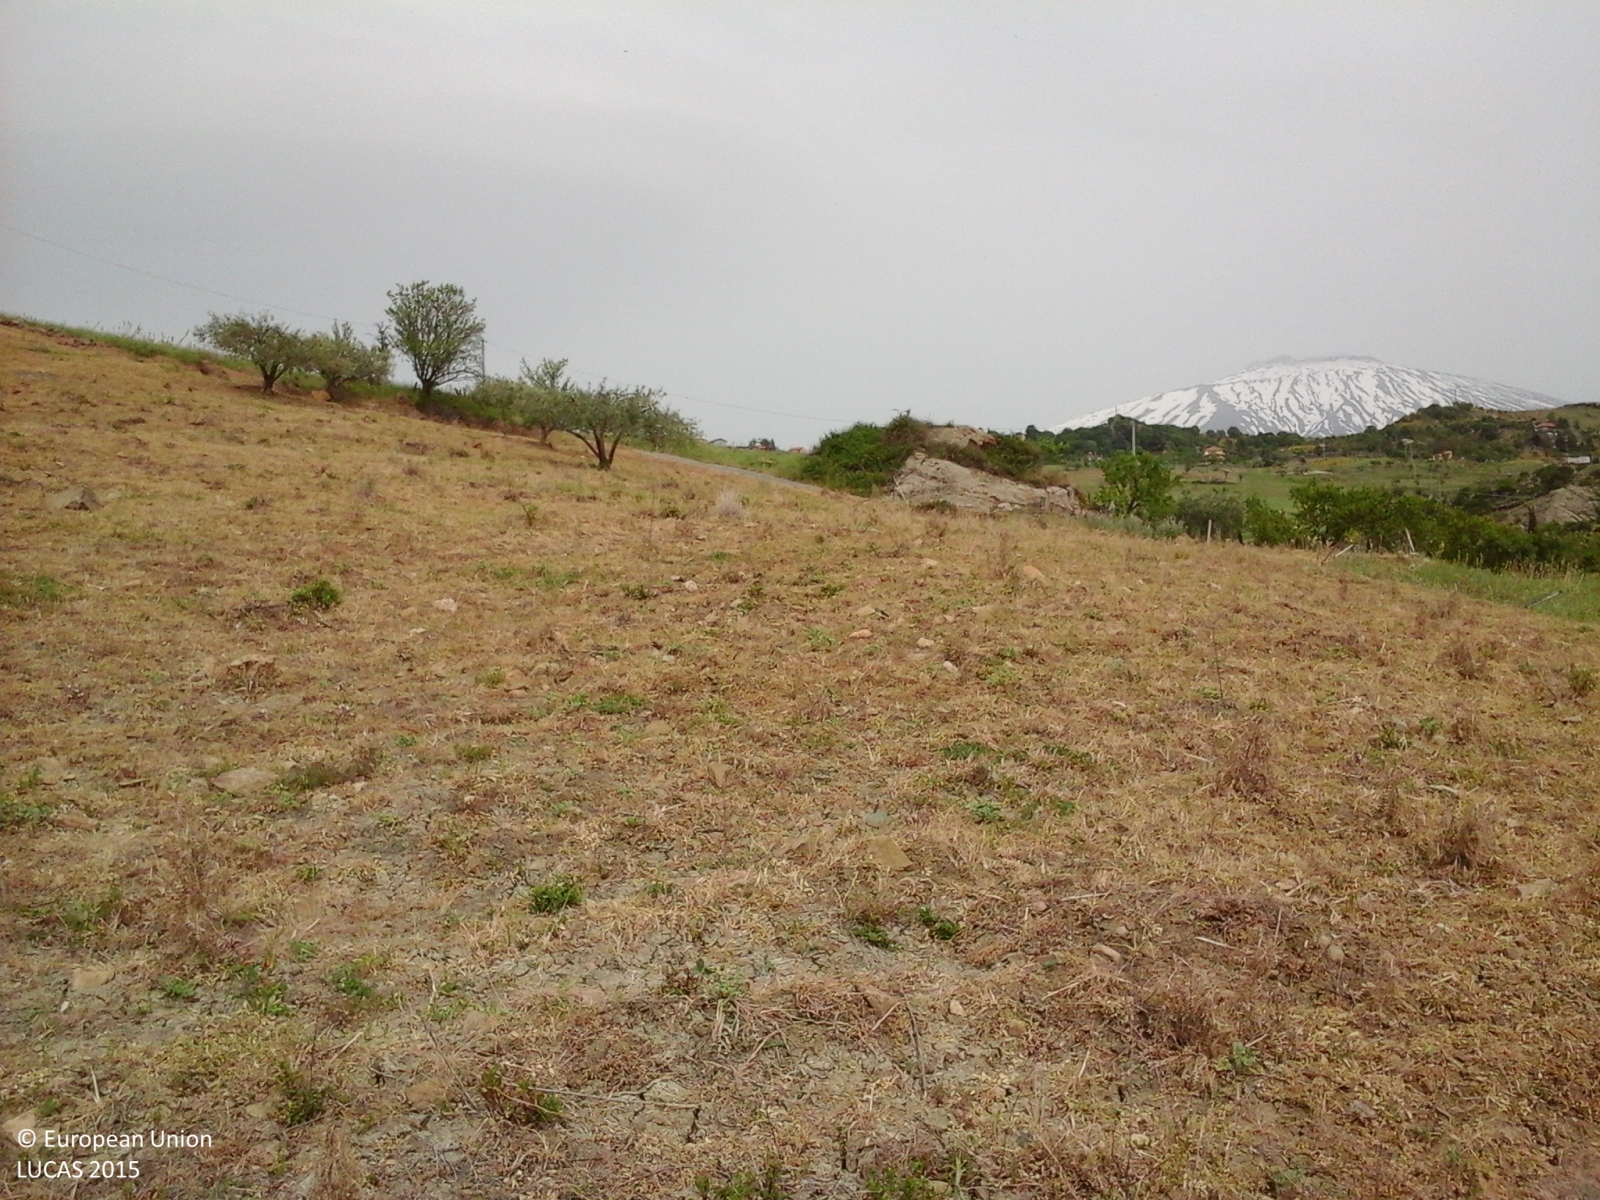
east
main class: Grassland
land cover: Spontaneously vegetated surfaces
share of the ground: > 75 %
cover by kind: herbaceous plants 100 %
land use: Agriculture (excluding fallow land and kitchen gardens)
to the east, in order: Spontaneously vegetated surfaces; Single bushes/trees; Grassland without tree/shrub cover; Spontaneously vegetated surfaces; Ditches and canals; Fences; Spontaneously vegetated surfaces; Grassland without tree/shrub cover; Olive groves; Spontaneously vegetated surfaces; Grassland without tree/shrub cover; Electric lines; Fences; Olive groves; Fences; Paved roads, cycling and walking lanes; Fences; Vineyards; Pear fruit
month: May
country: IT
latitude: 37.8061
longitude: 14.8391
